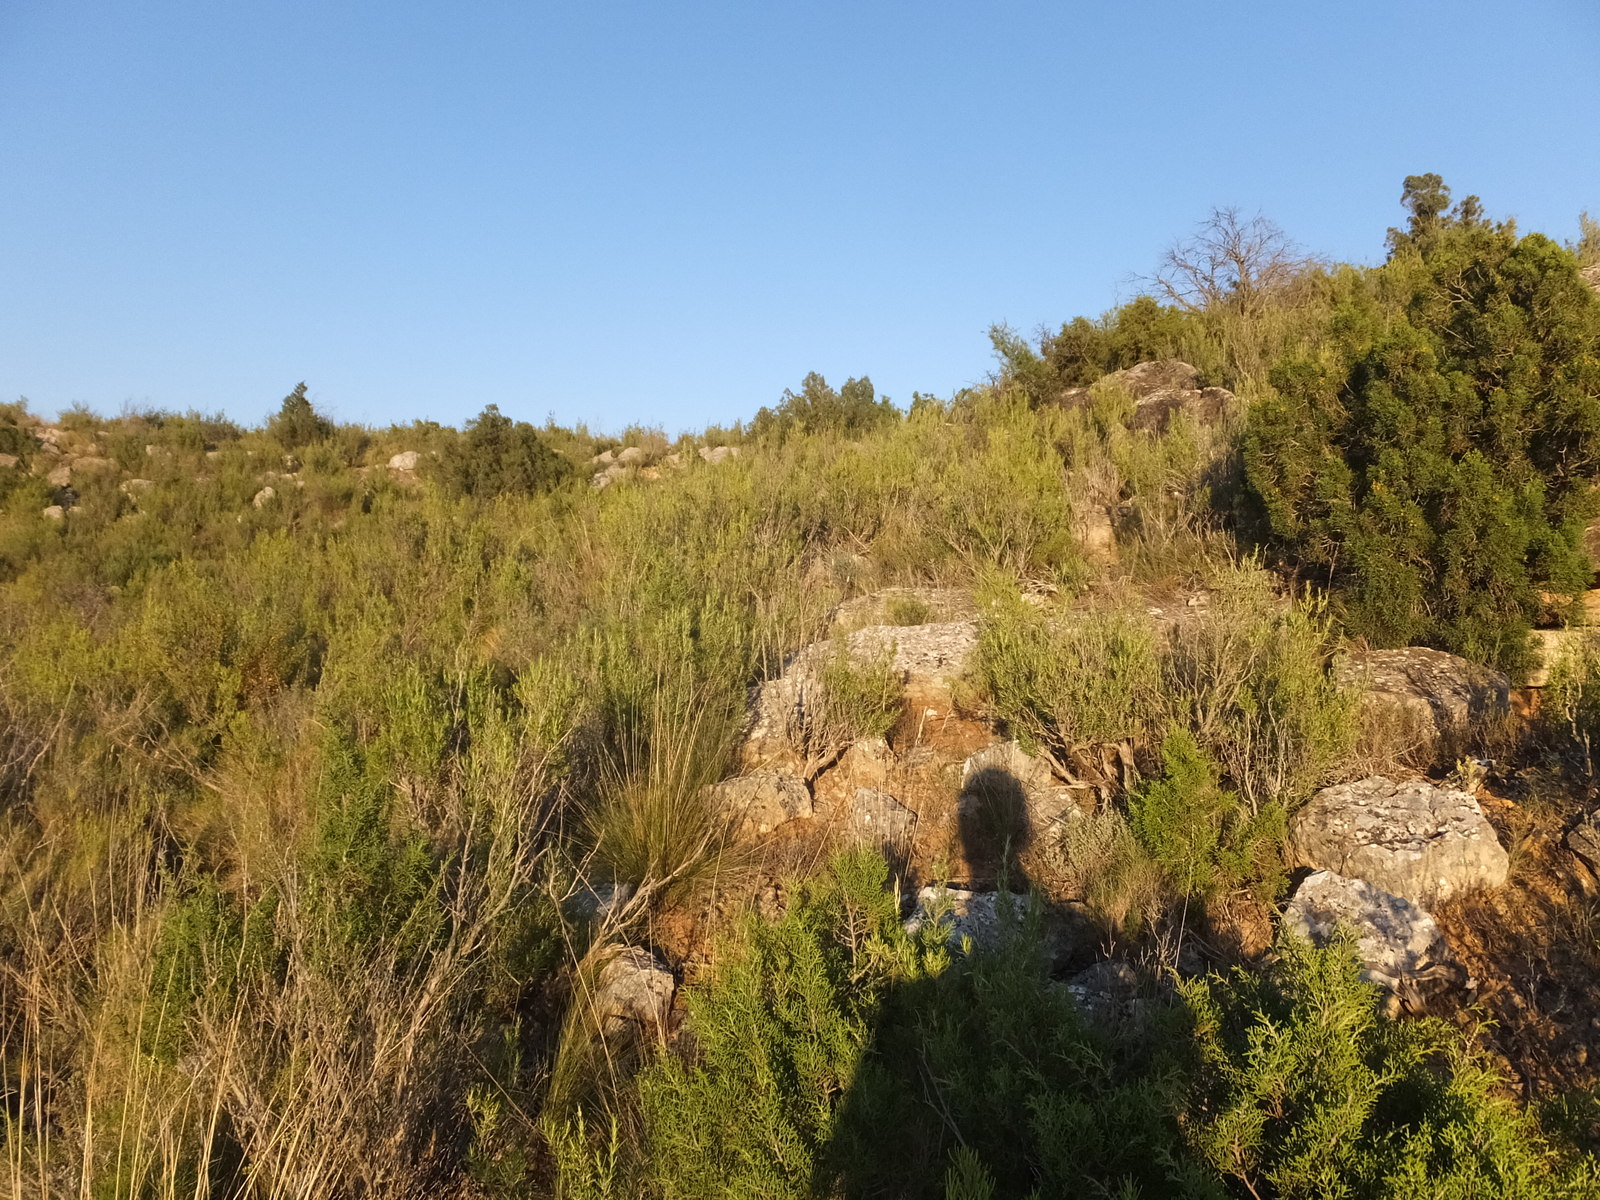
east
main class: Shrubland
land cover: Shrubland with sparse tree cover
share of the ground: > 75 %
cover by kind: shrubs 75 %, herbaceous plants 20 %, coniferous forest trees 5 %
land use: Semi-natural and natural areas not in use
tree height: < 5 m
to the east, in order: Shrubland with sparse tree cover; Pine dominated coniferous woodland; Shrubland without tree cover
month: June
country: ES
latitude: 41.3087
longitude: -0.2988
